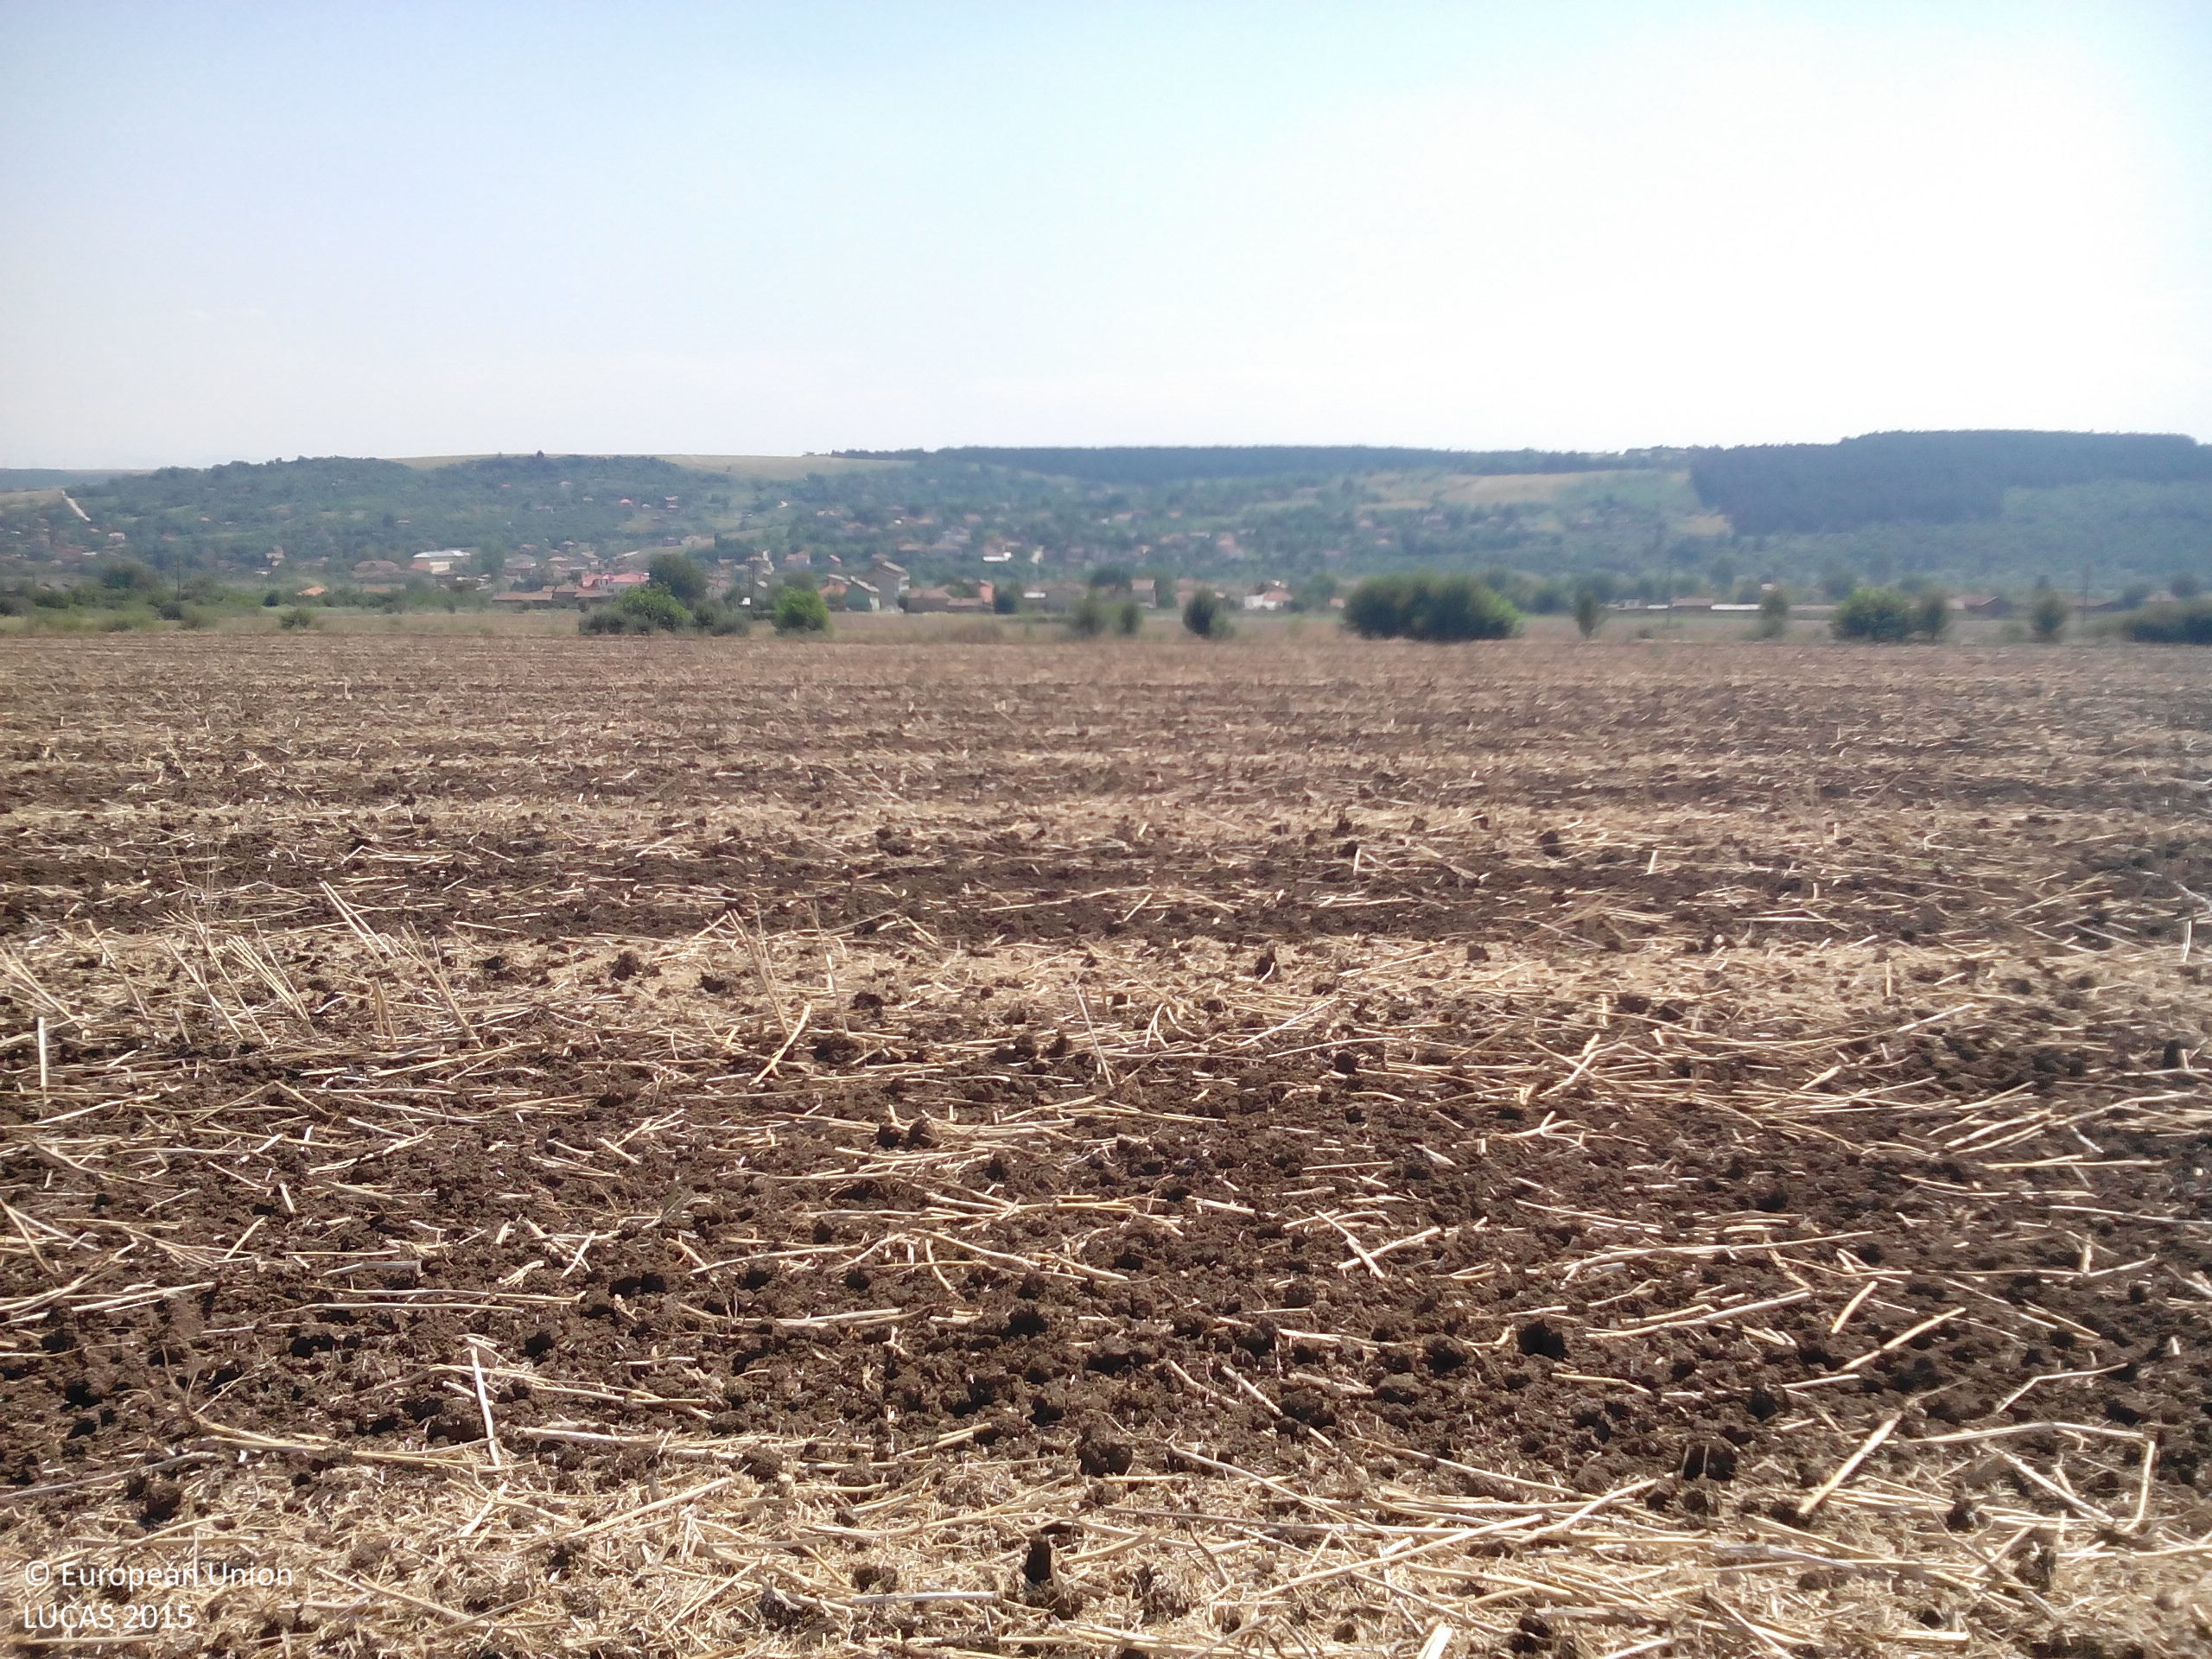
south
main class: Cropland
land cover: Rape and turnip rape
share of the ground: < 10 %
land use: Agriculture (excluding fallow land and kitchen gardens)
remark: Harvested field
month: July
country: BG
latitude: 43.2886
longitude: 24.1150
